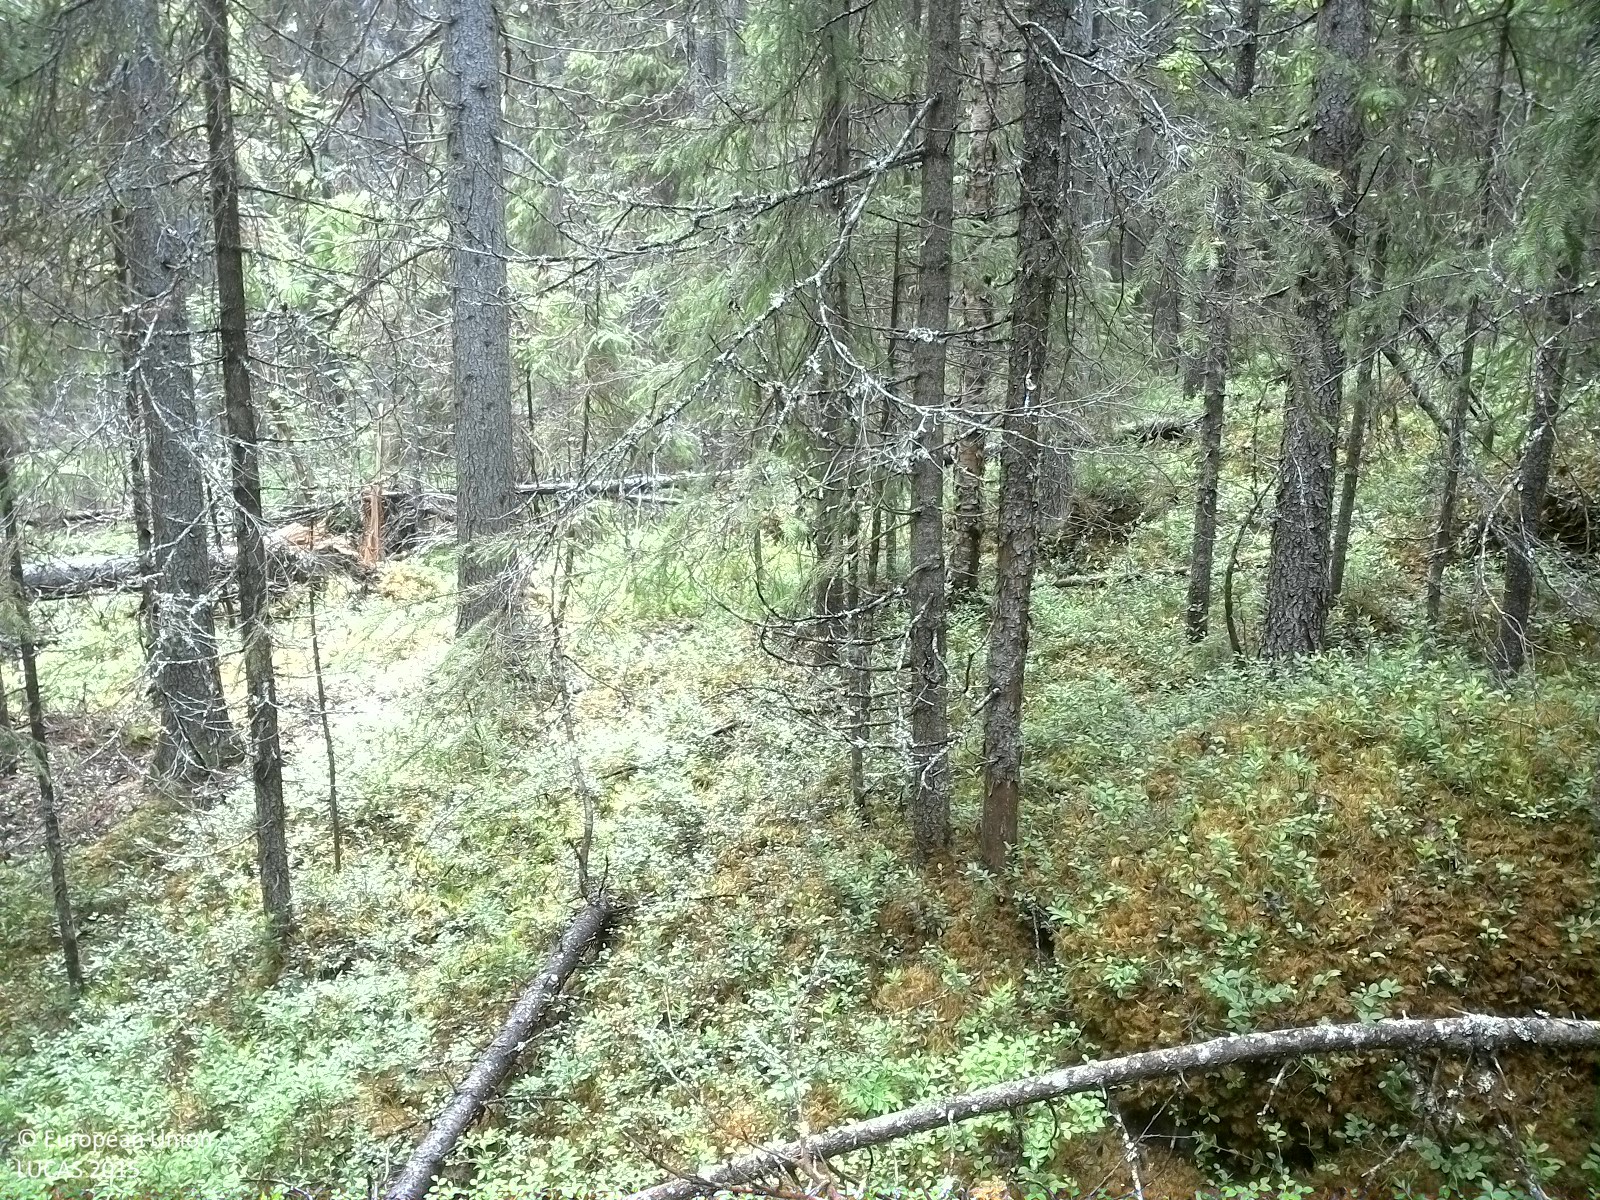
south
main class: Woodland
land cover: Spruce dominated coniferous woodland
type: boreal forest
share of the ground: > 75 %
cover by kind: coniferous forest trees 80 %, shrubs 15 %, broadleaved forest trees 5 %
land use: Forestry
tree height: > 5 m
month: July
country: SE
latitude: 63.5674
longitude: 15.3111
